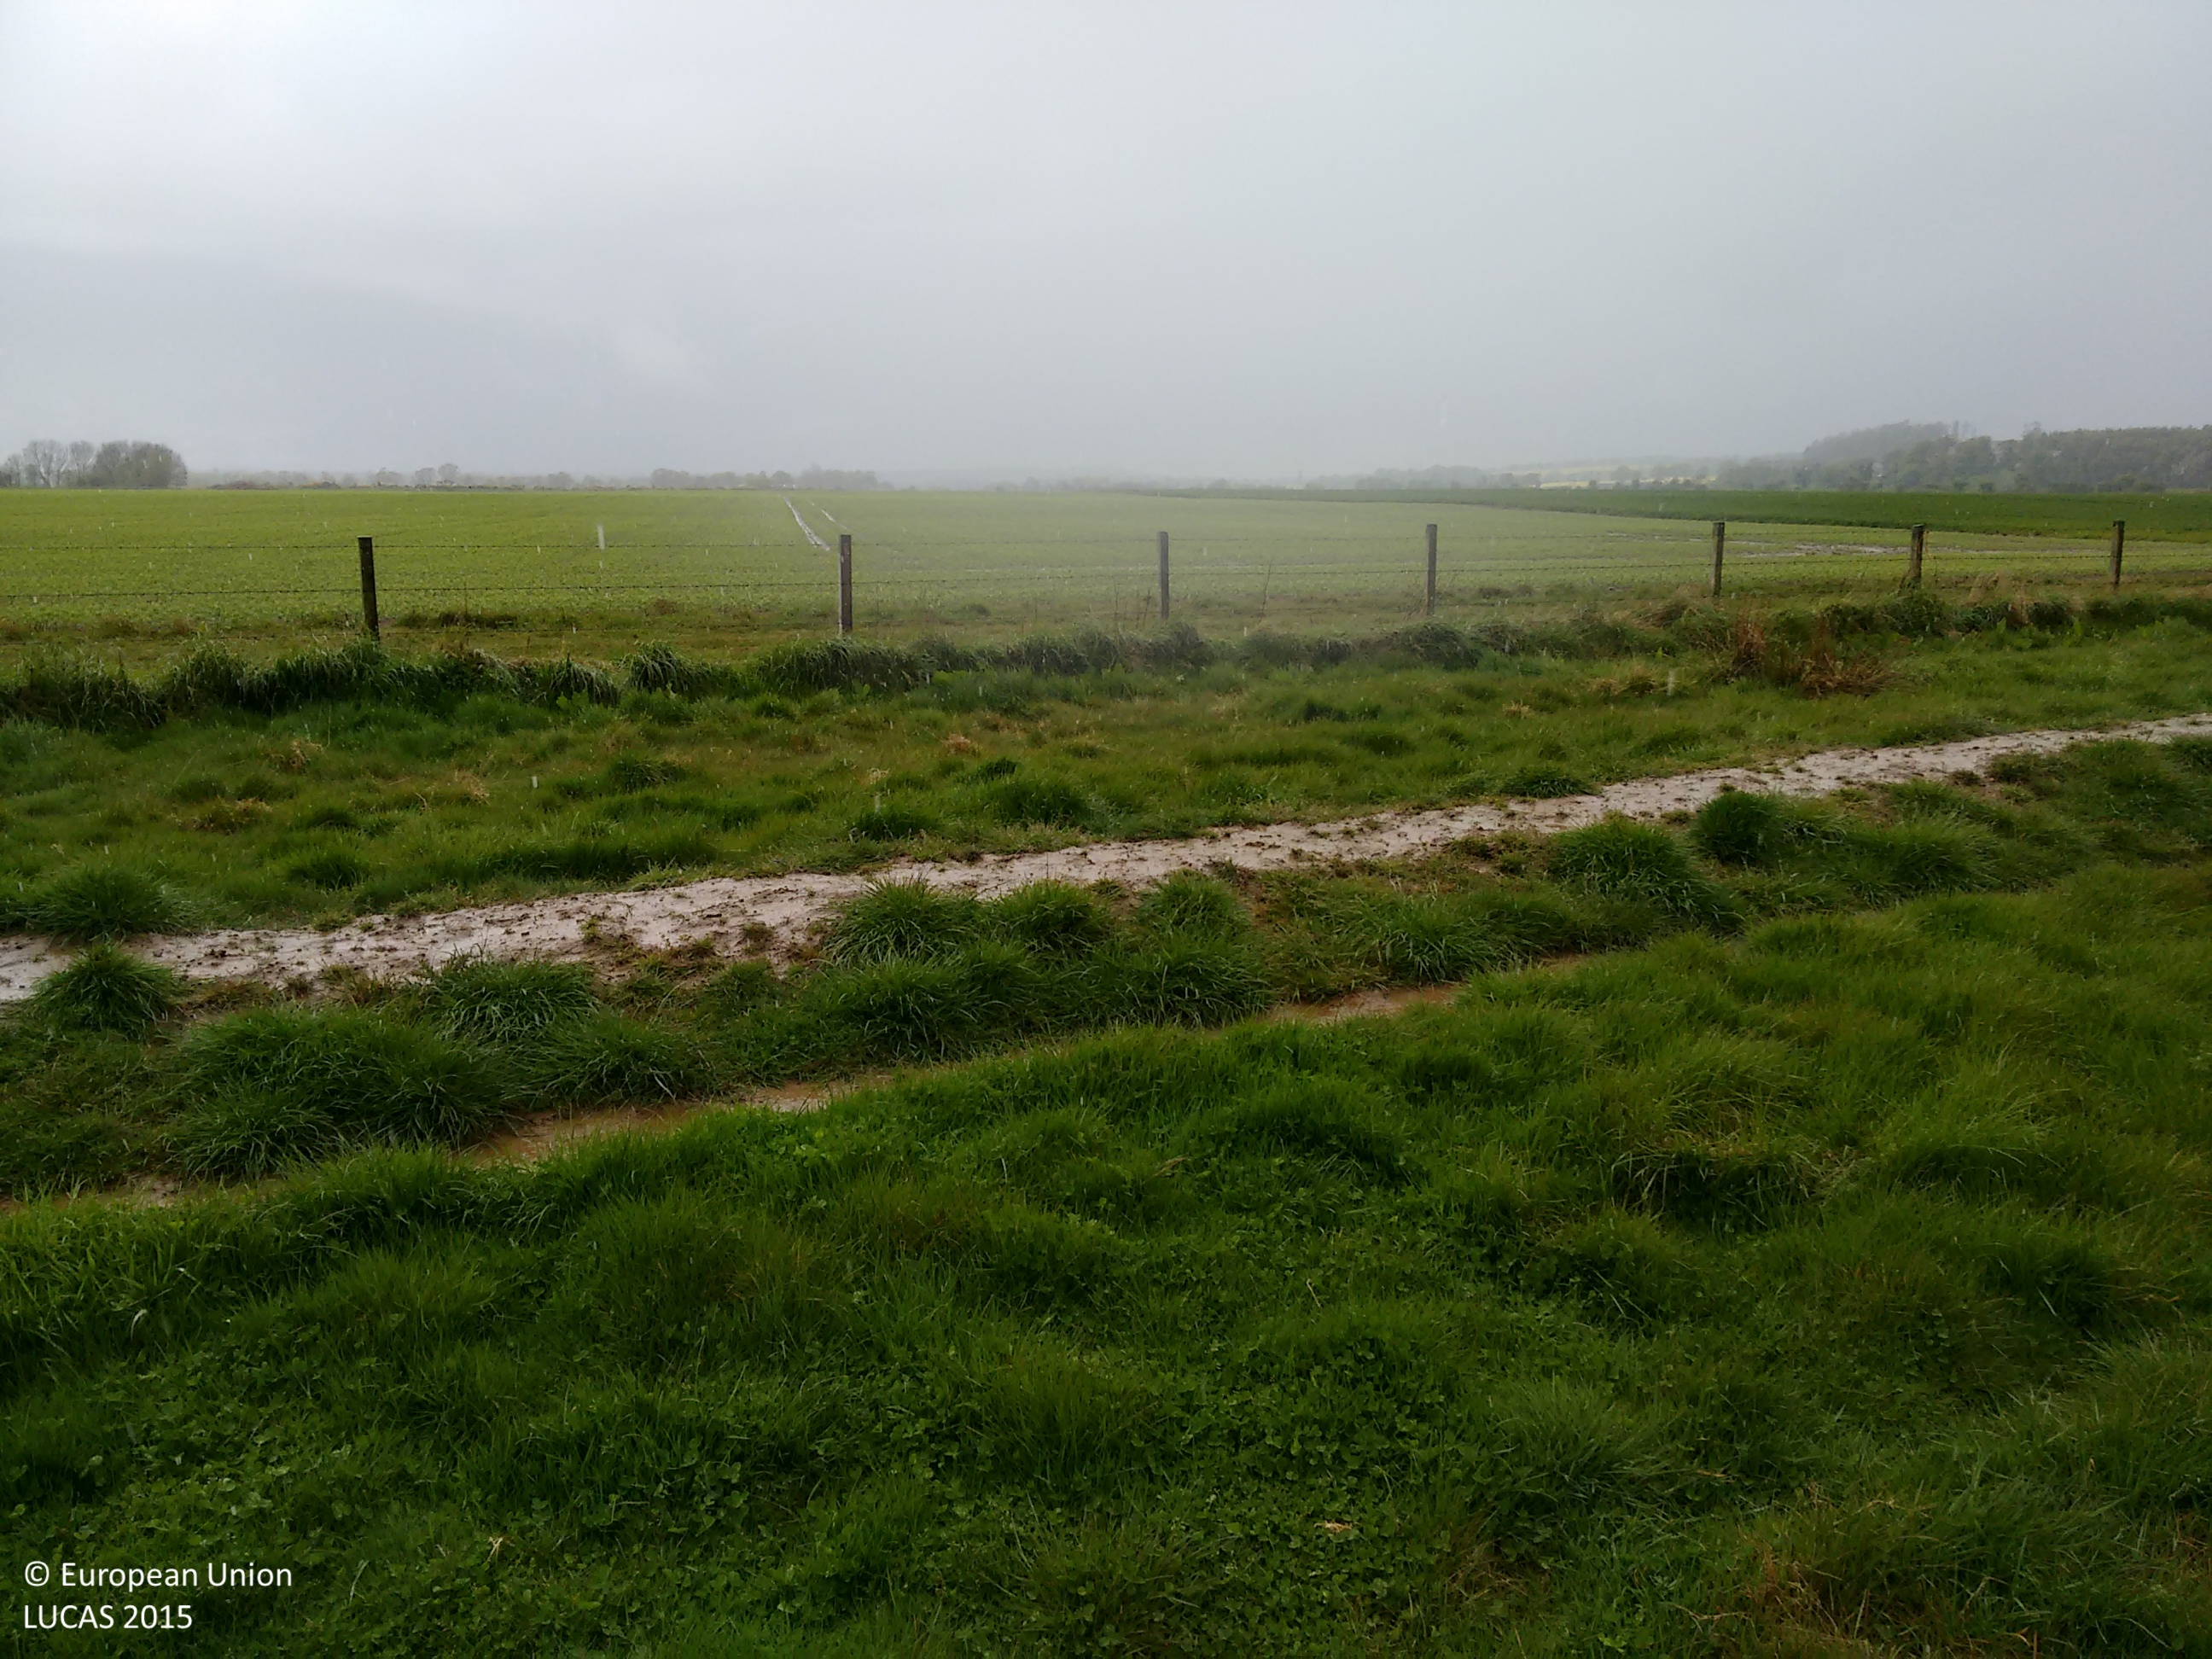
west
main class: Grassland
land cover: Grassland without tree/shrub cover
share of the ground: > 75 %
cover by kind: herbaceous plants 100 %
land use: Agriculture (excluding fallow land and kitchen gardens)
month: May
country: GB
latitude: 56.7192
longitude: -2.5239
